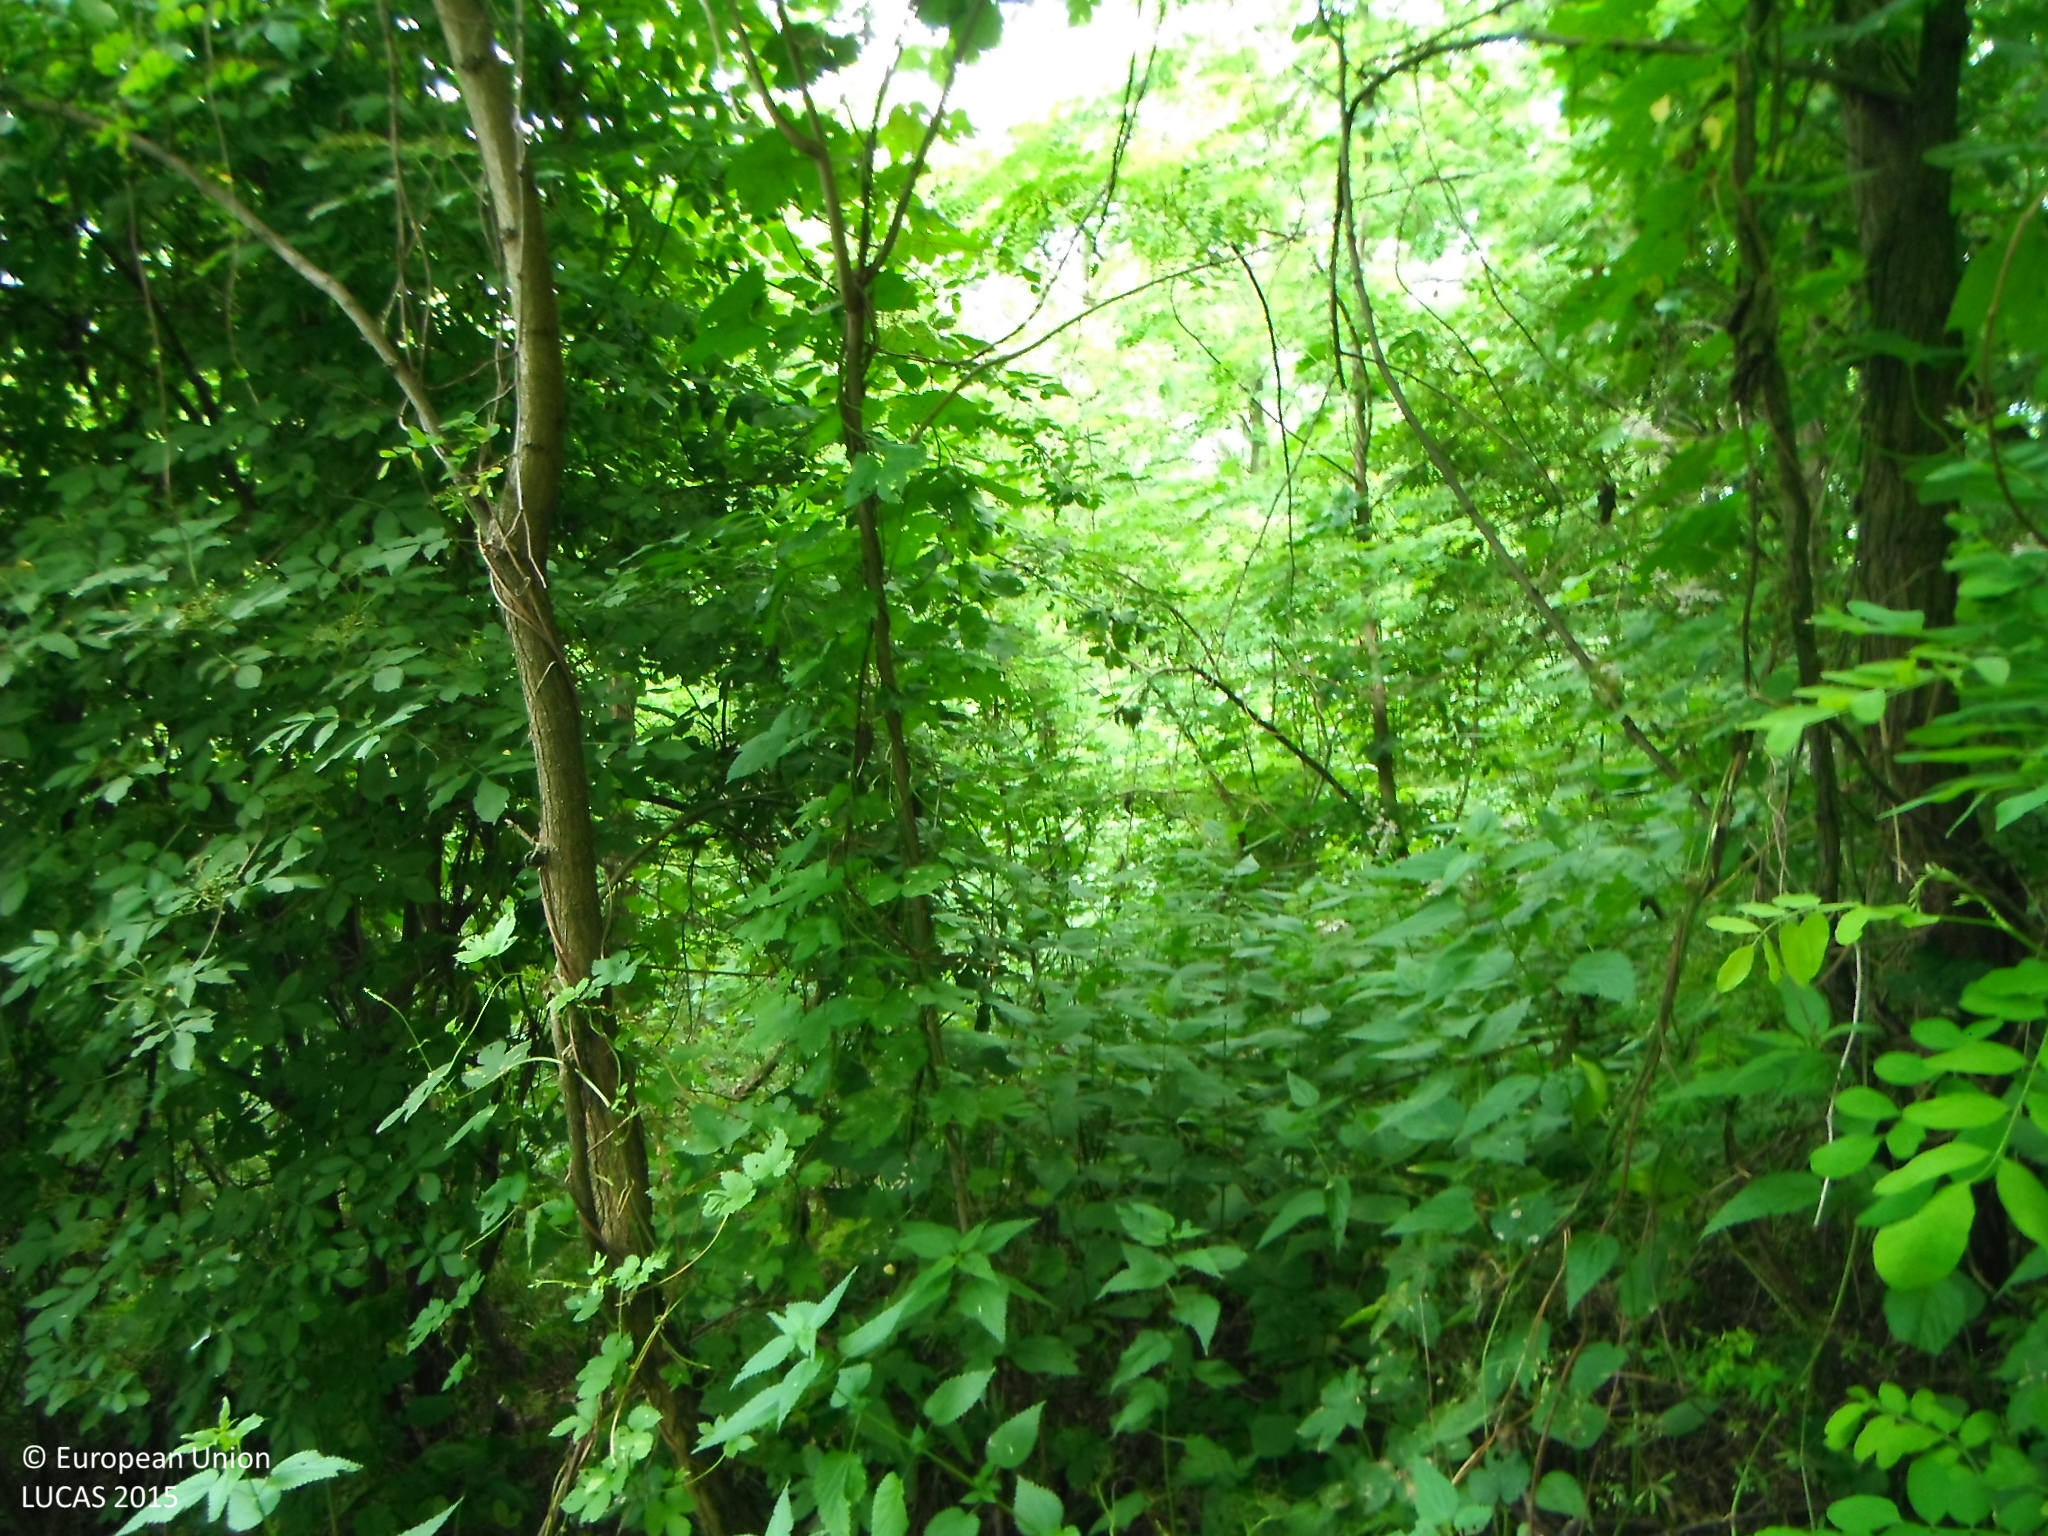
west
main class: Woodland
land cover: Broadleaved woodland
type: mesophytic deciduous forest
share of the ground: > 75 %
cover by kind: broadleaved forest trees 100 %
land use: Forestry
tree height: > 5 m
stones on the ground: < 10 %
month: July
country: SK
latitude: 48.6505
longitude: 20.0617
